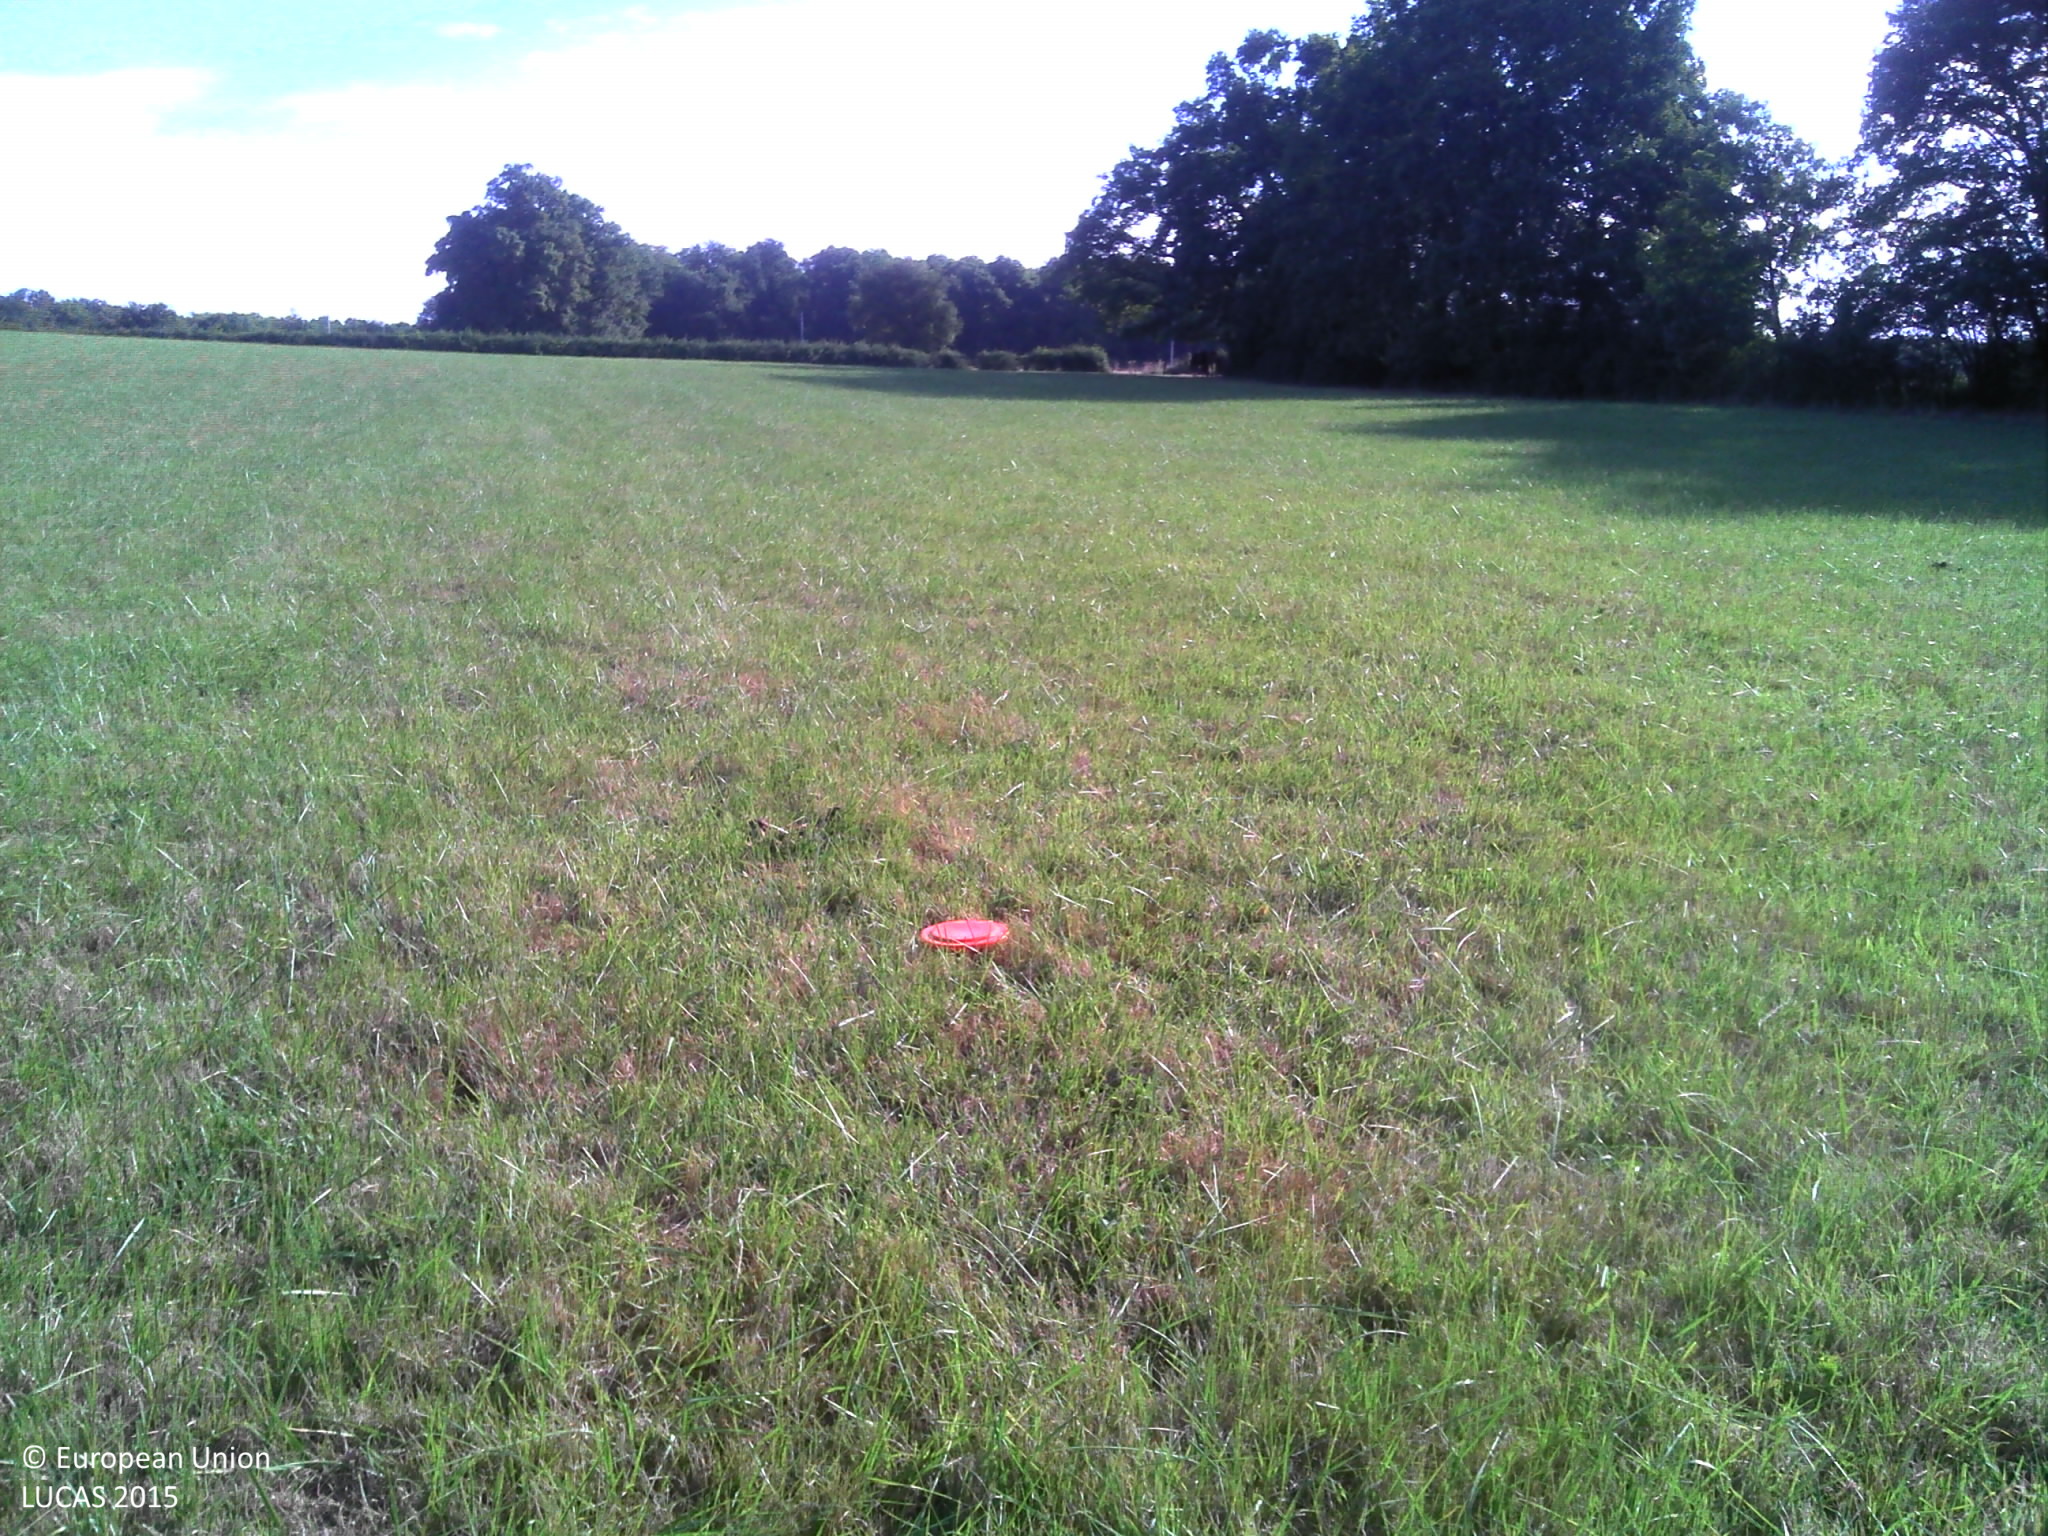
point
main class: Grassland
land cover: Grassland without tree/shrub cover
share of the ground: > 75 %
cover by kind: herbaceous plants 100 %
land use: Agriculture (excluding fallow land and kitchen gardens)
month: July
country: FR
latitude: 47.7576
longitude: 3.4452
